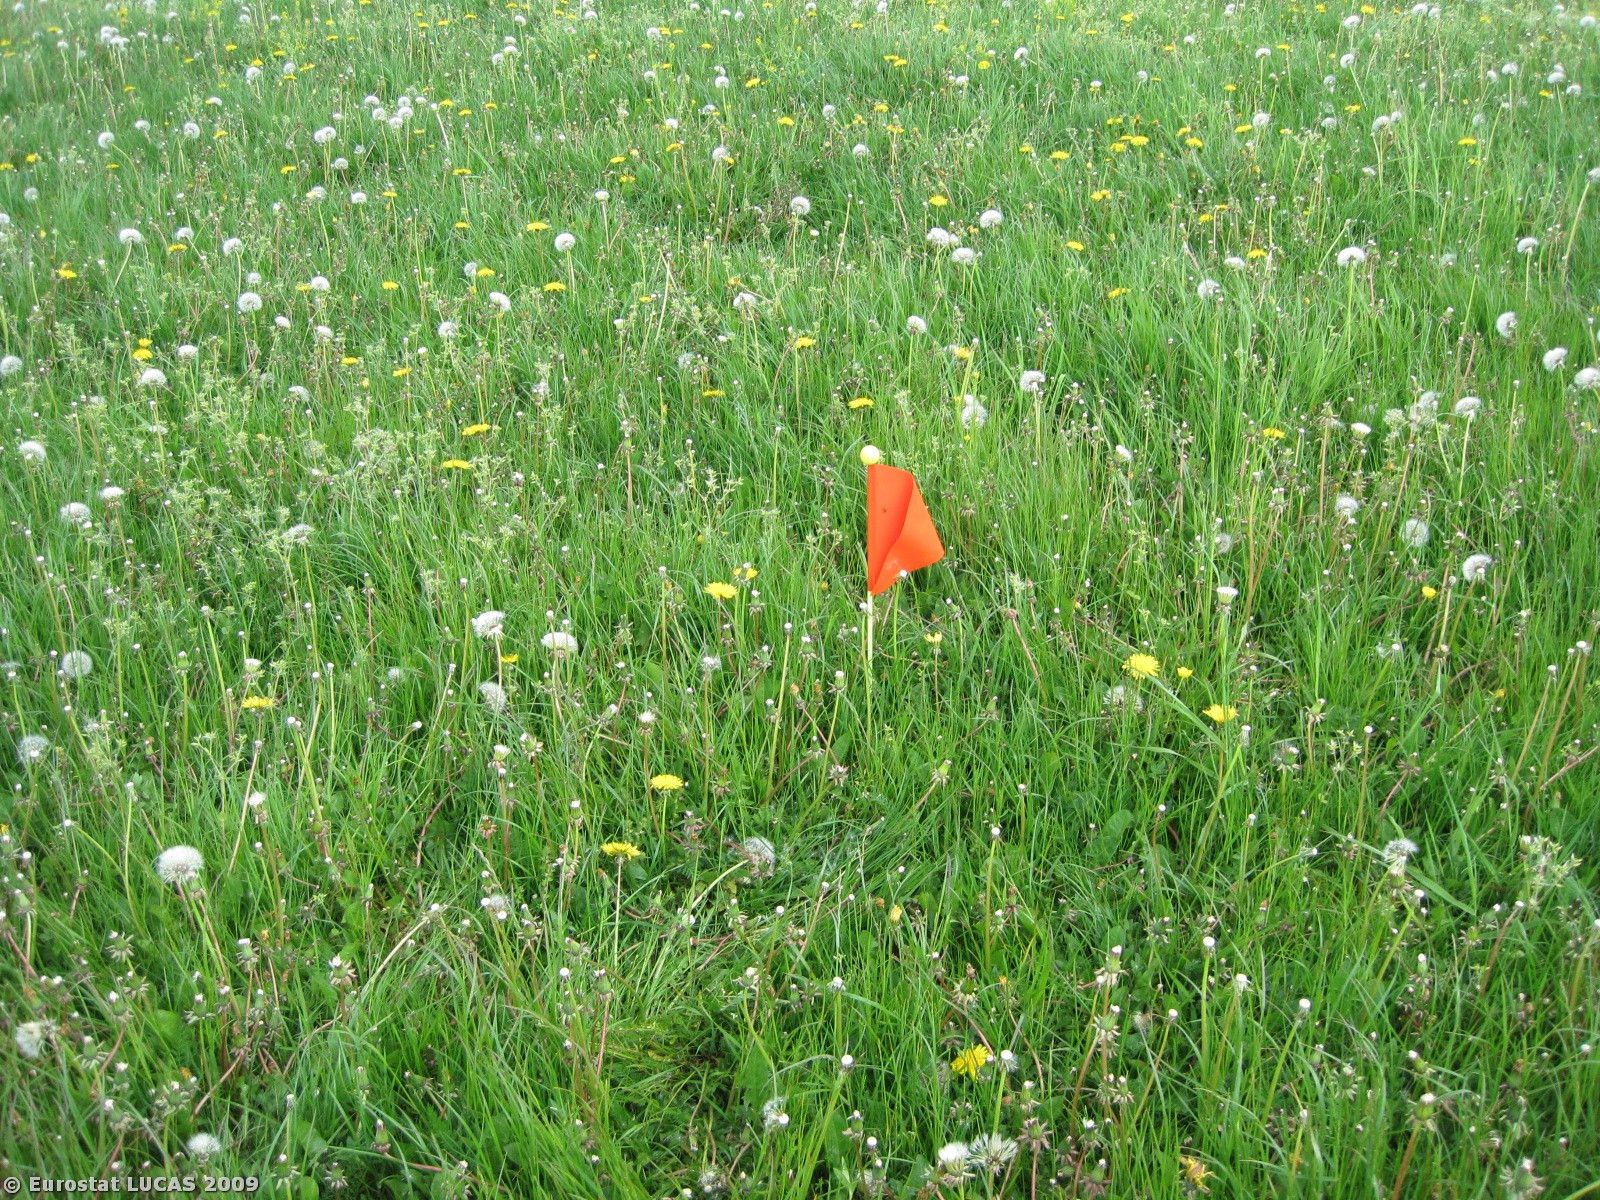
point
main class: Grassland
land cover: Grassland without tree/shrub cover
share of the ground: > 75 %
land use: Agriculture (excluding fallow land and kitchen gardens)
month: May
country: DK
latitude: 56.7268
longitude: 9.7552
